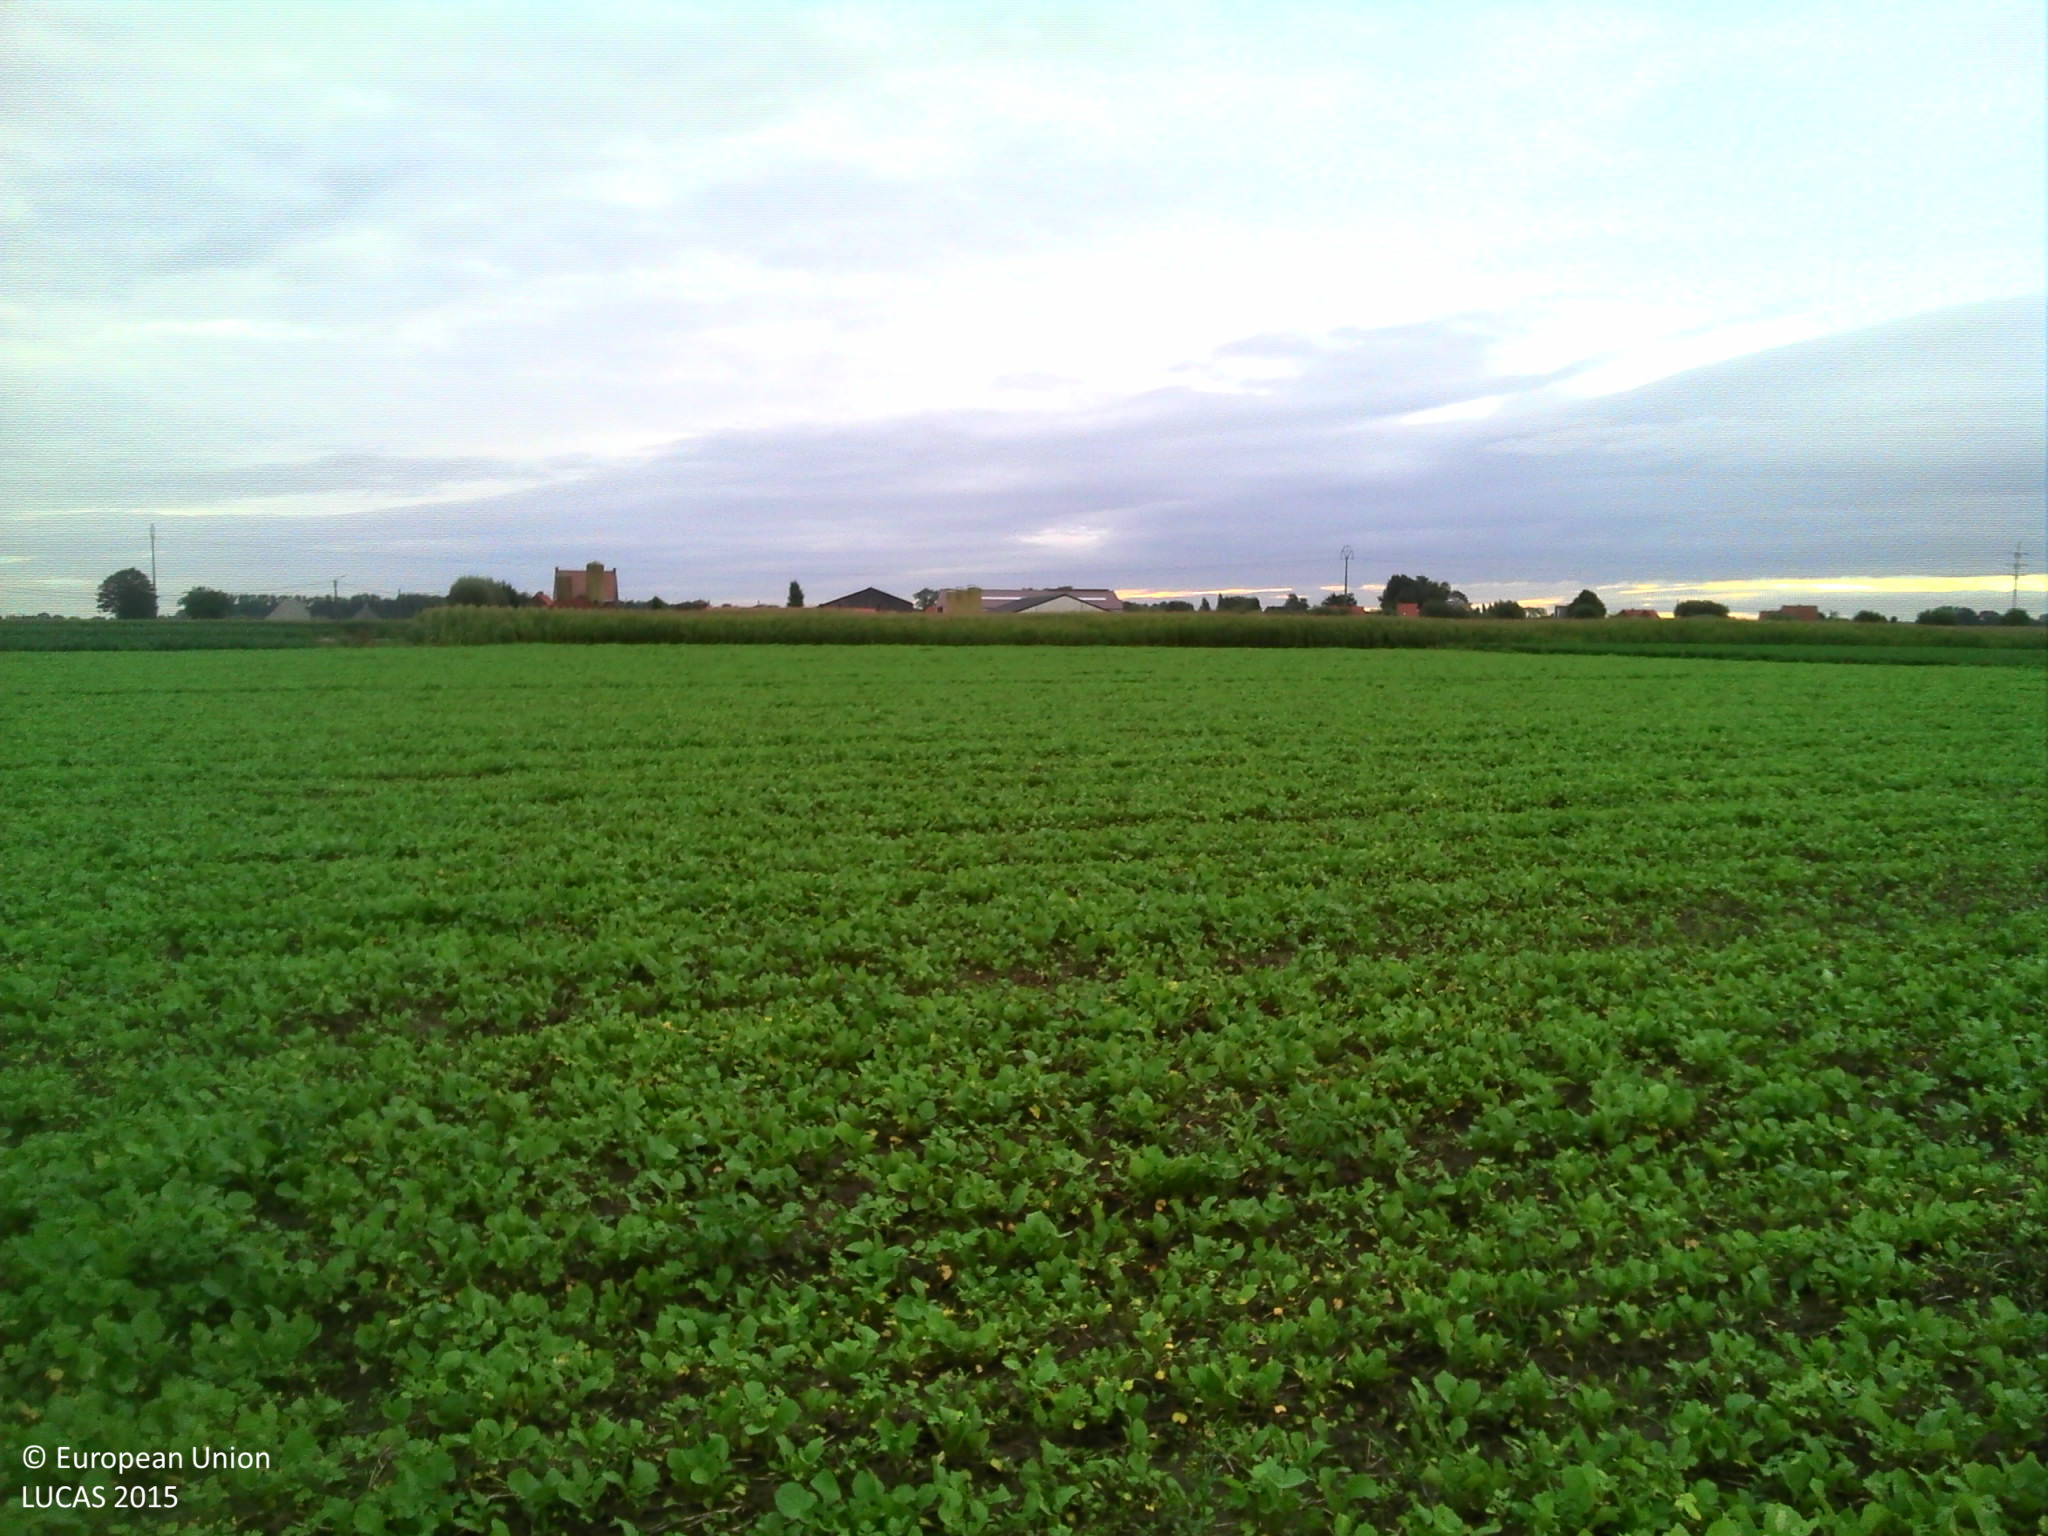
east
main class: Cropland
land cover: Other fibre and oleaginous crops
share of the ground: > 75 %
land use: Agriculture (excluding fallow land and kitchen gardens)
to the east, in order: Other fibre and oleaginous crops; Maize; Fences; Grassland without tree/shrub cover
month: September
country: BE
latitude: 51.1047
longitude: 2.9773
